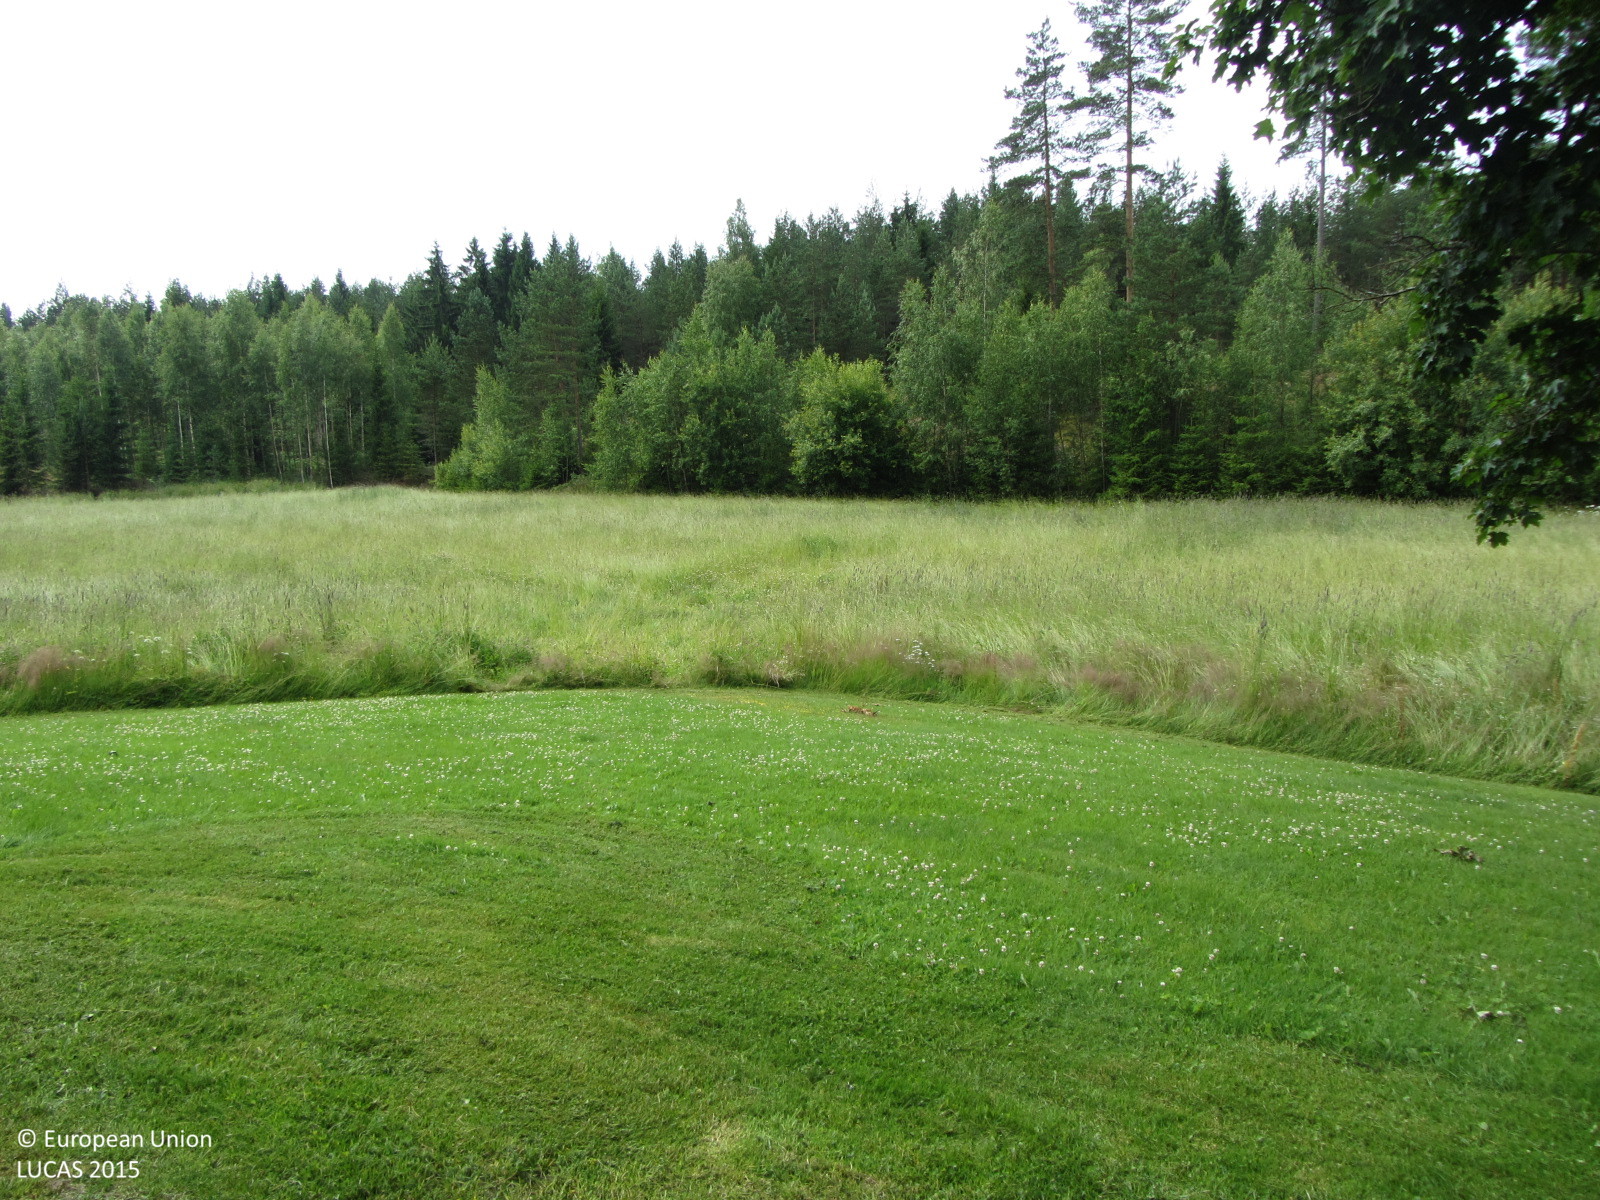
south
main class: Grassland
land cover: Grassland with sparse tree/shrub cover
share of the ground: > 75 %
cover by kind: herbaceous plants 85 %, shrubs 10 %, broadleaved forest trees 5 %
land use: Residential
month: July
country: FI
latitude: 60.0724
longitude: 24.0992
